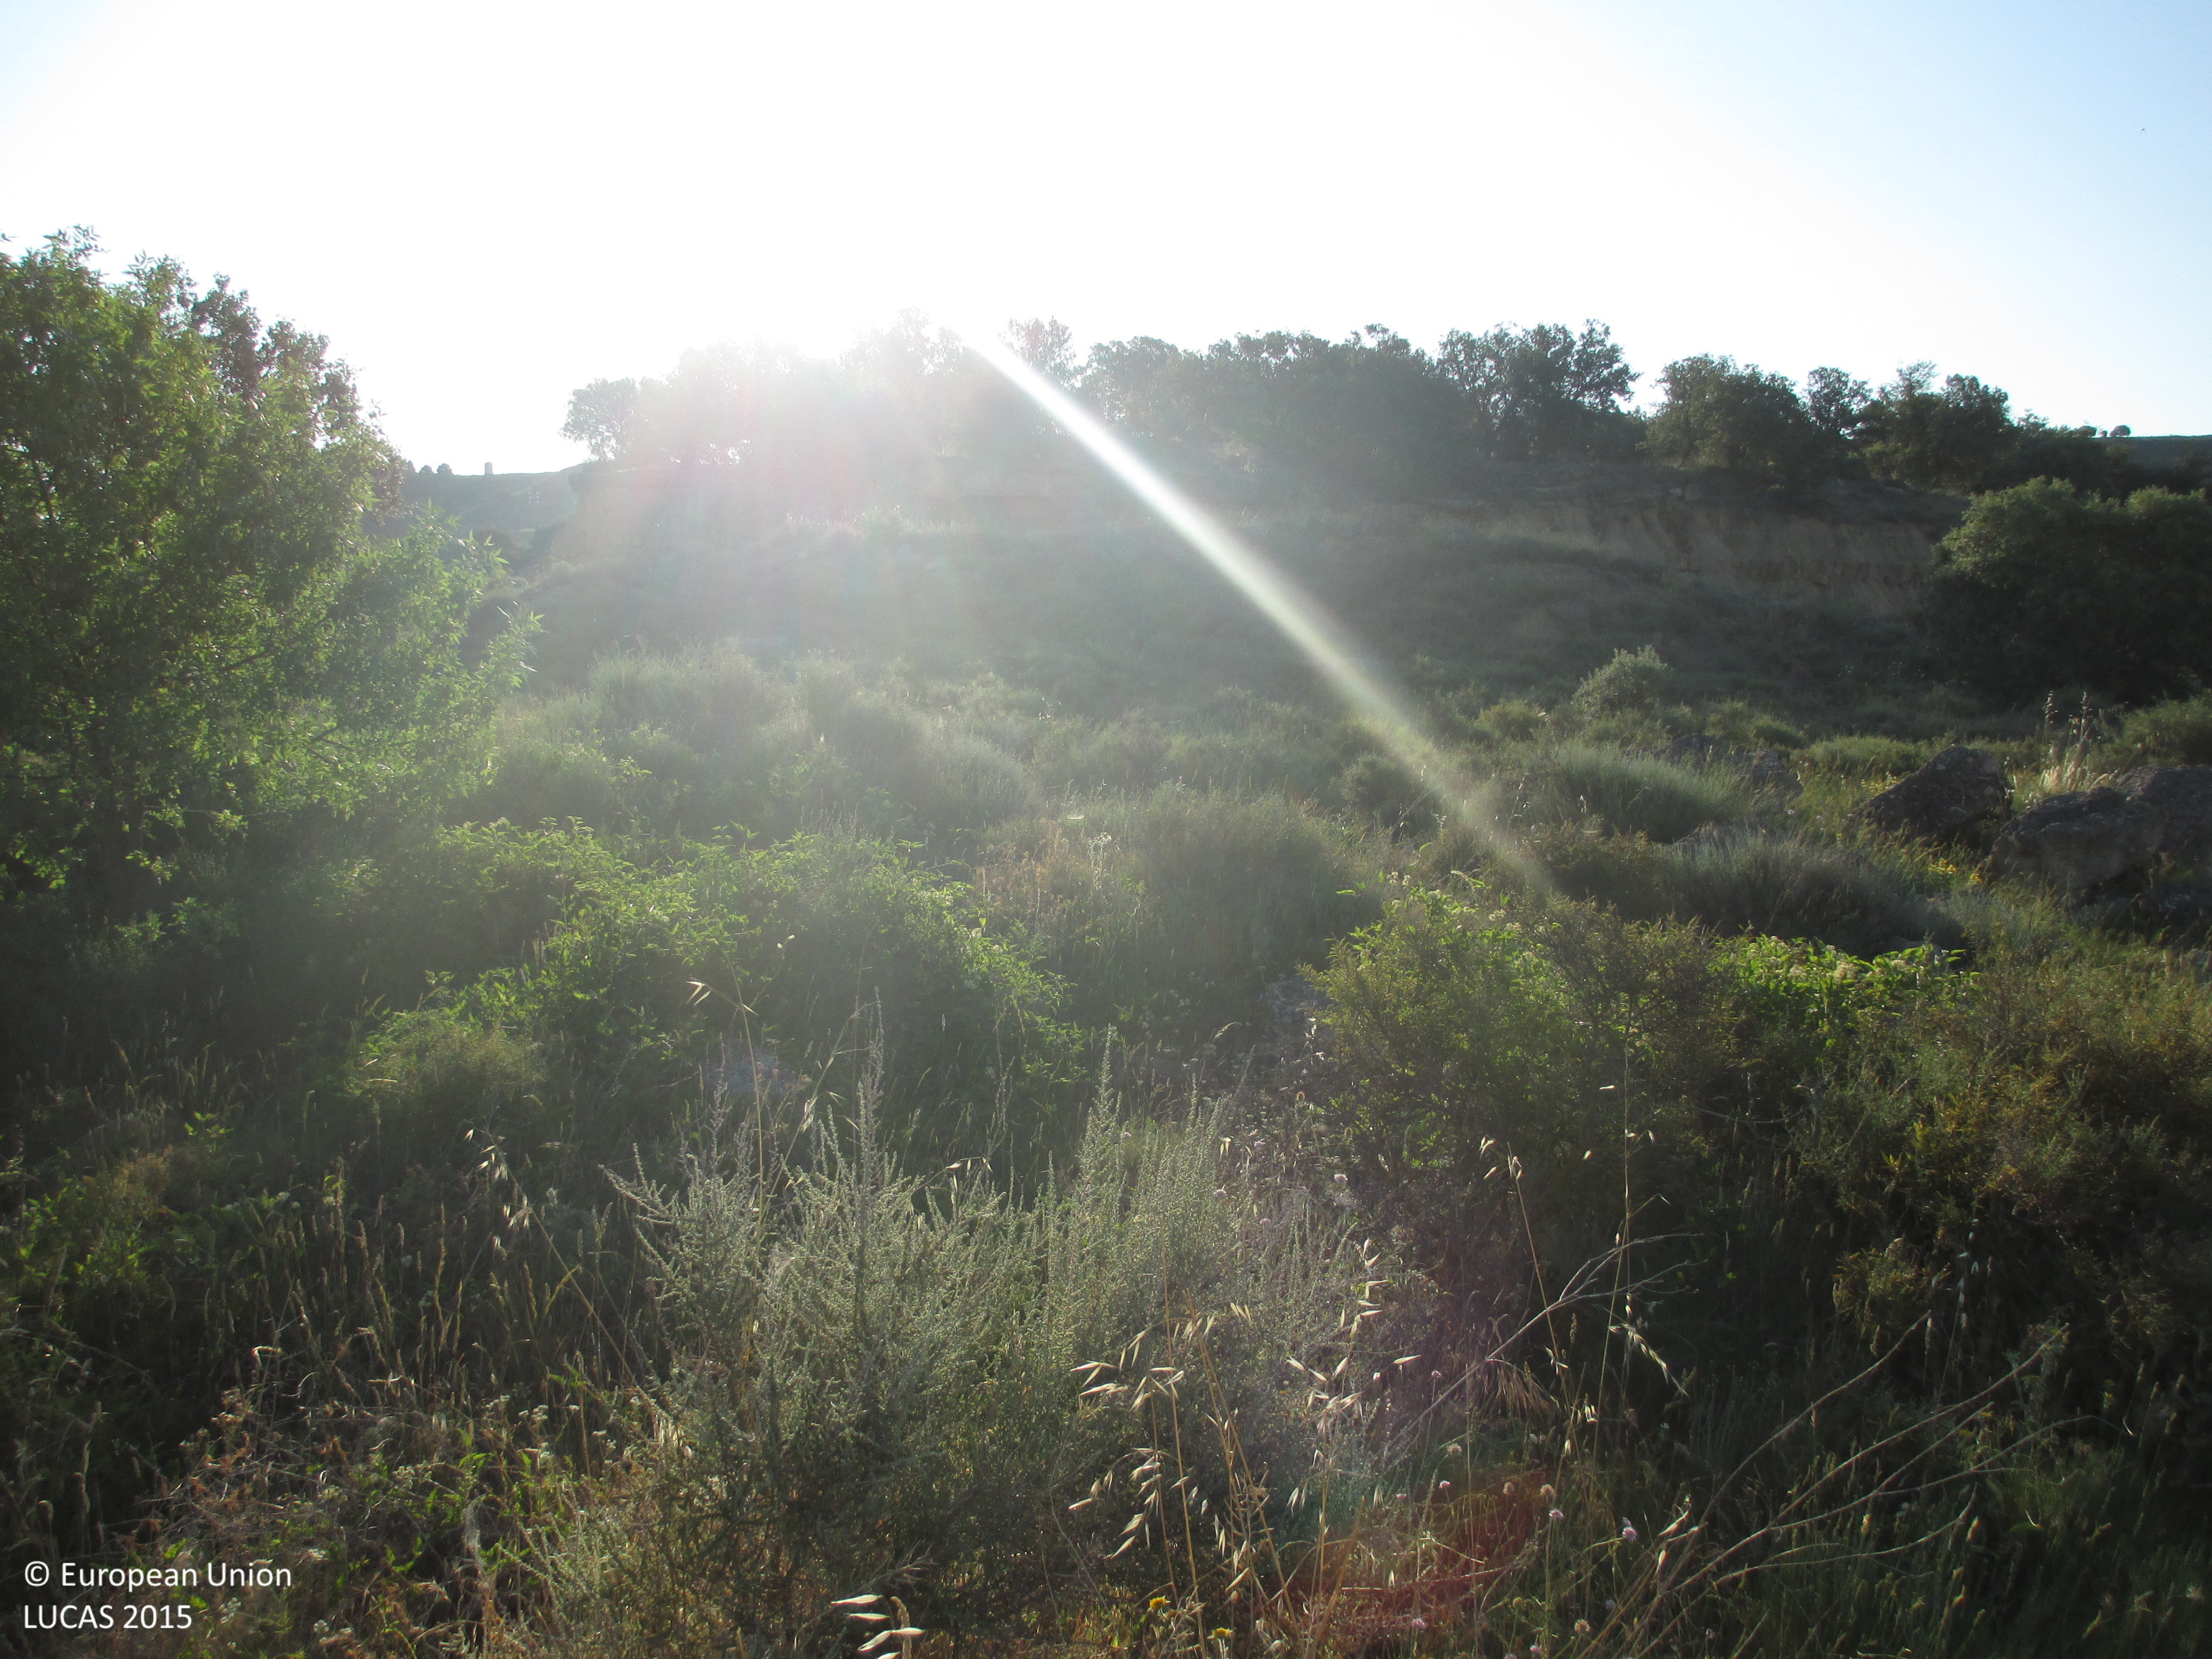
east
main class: Grassland
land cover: Grassland with sparse tree/shrub cover
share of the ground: > 75 %
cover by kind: herbaceous plants 90 %, broadleaved forest trees 5 %, shrubs 5 %
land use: Semi-natural and natural areas not in use
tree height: < 5 m
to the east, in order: Grassland with sparse tree/shrub cover; Shrubland with sparse tree cover; Broadleaved woodland; Grassland with sparse tree/shrub cover; Broadleaved woodland; Grassland with sparse tree/shrub cover
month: June
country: ES
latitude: 42.1413
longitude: -0.3431
